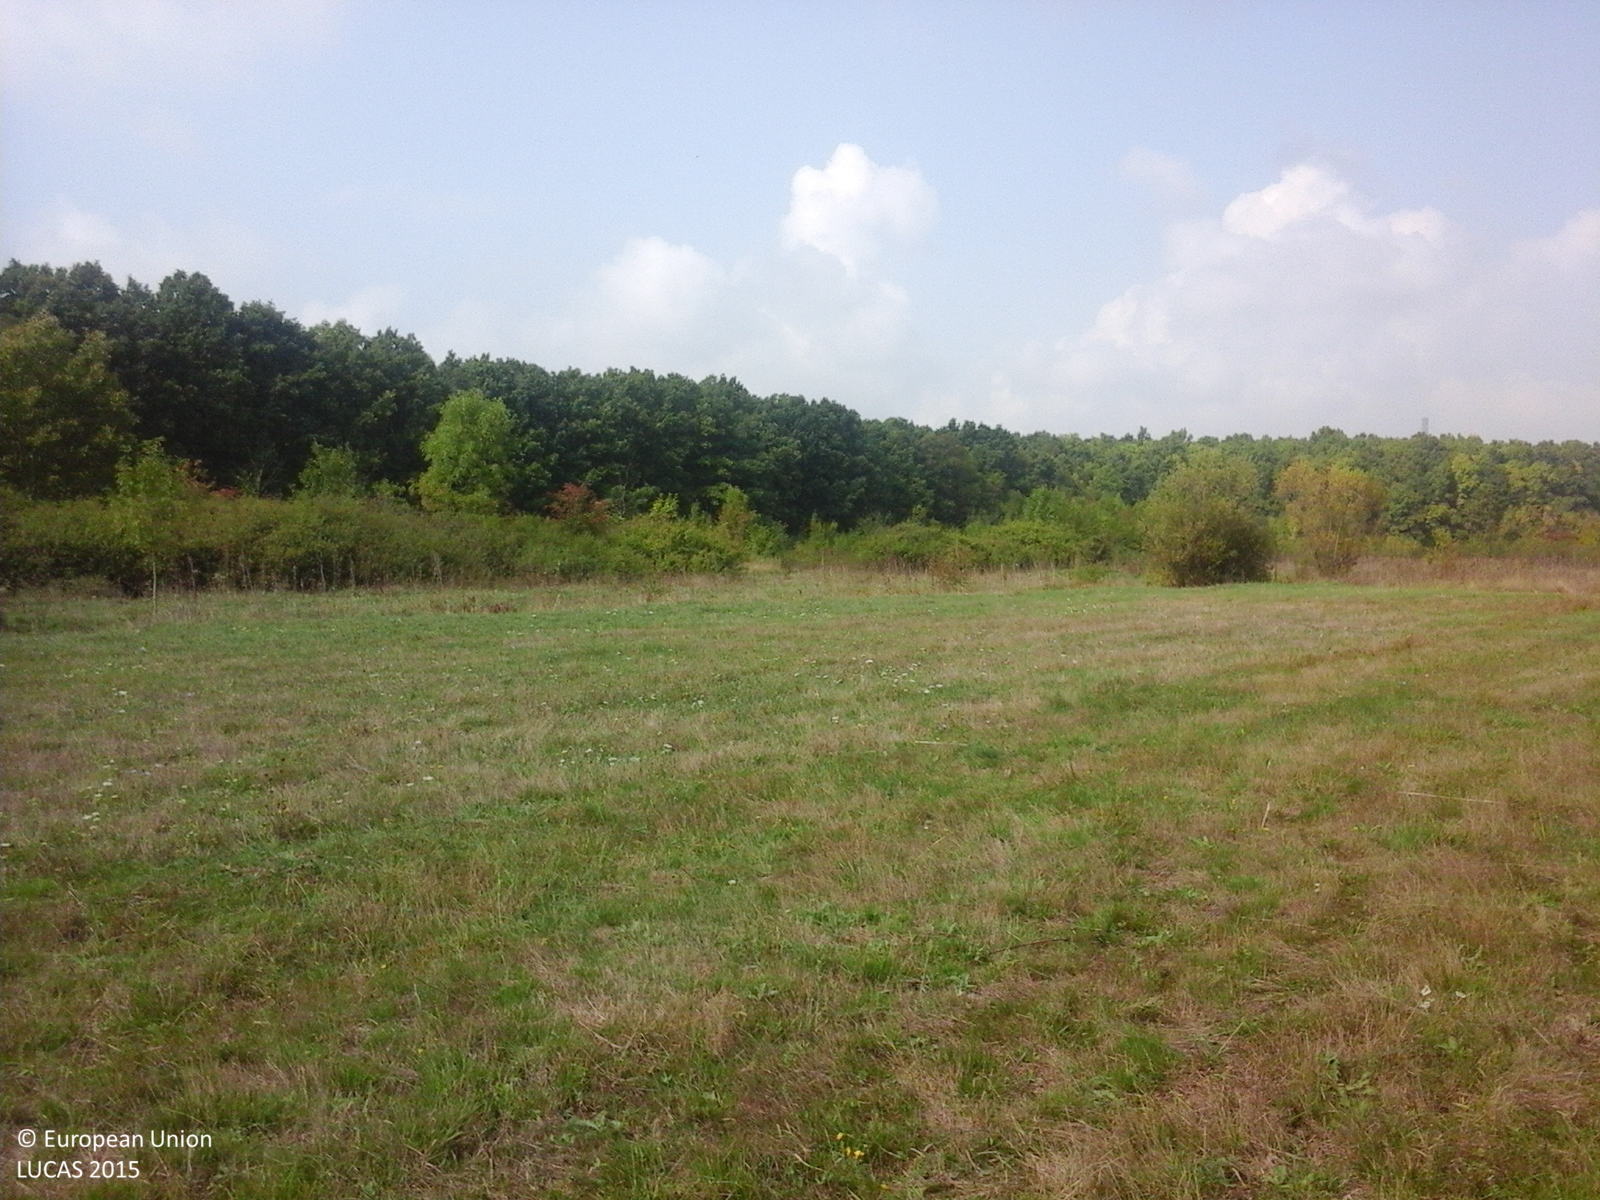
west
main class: Grassland
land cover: Grassland without tree/shrub cover
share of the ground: > 75 %
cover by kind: herbaceous plants 100 %
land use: Agriculture (excluding fallow land and kitchen gardens)
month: September
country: RO
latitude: 44.9893
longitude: 23.2826
